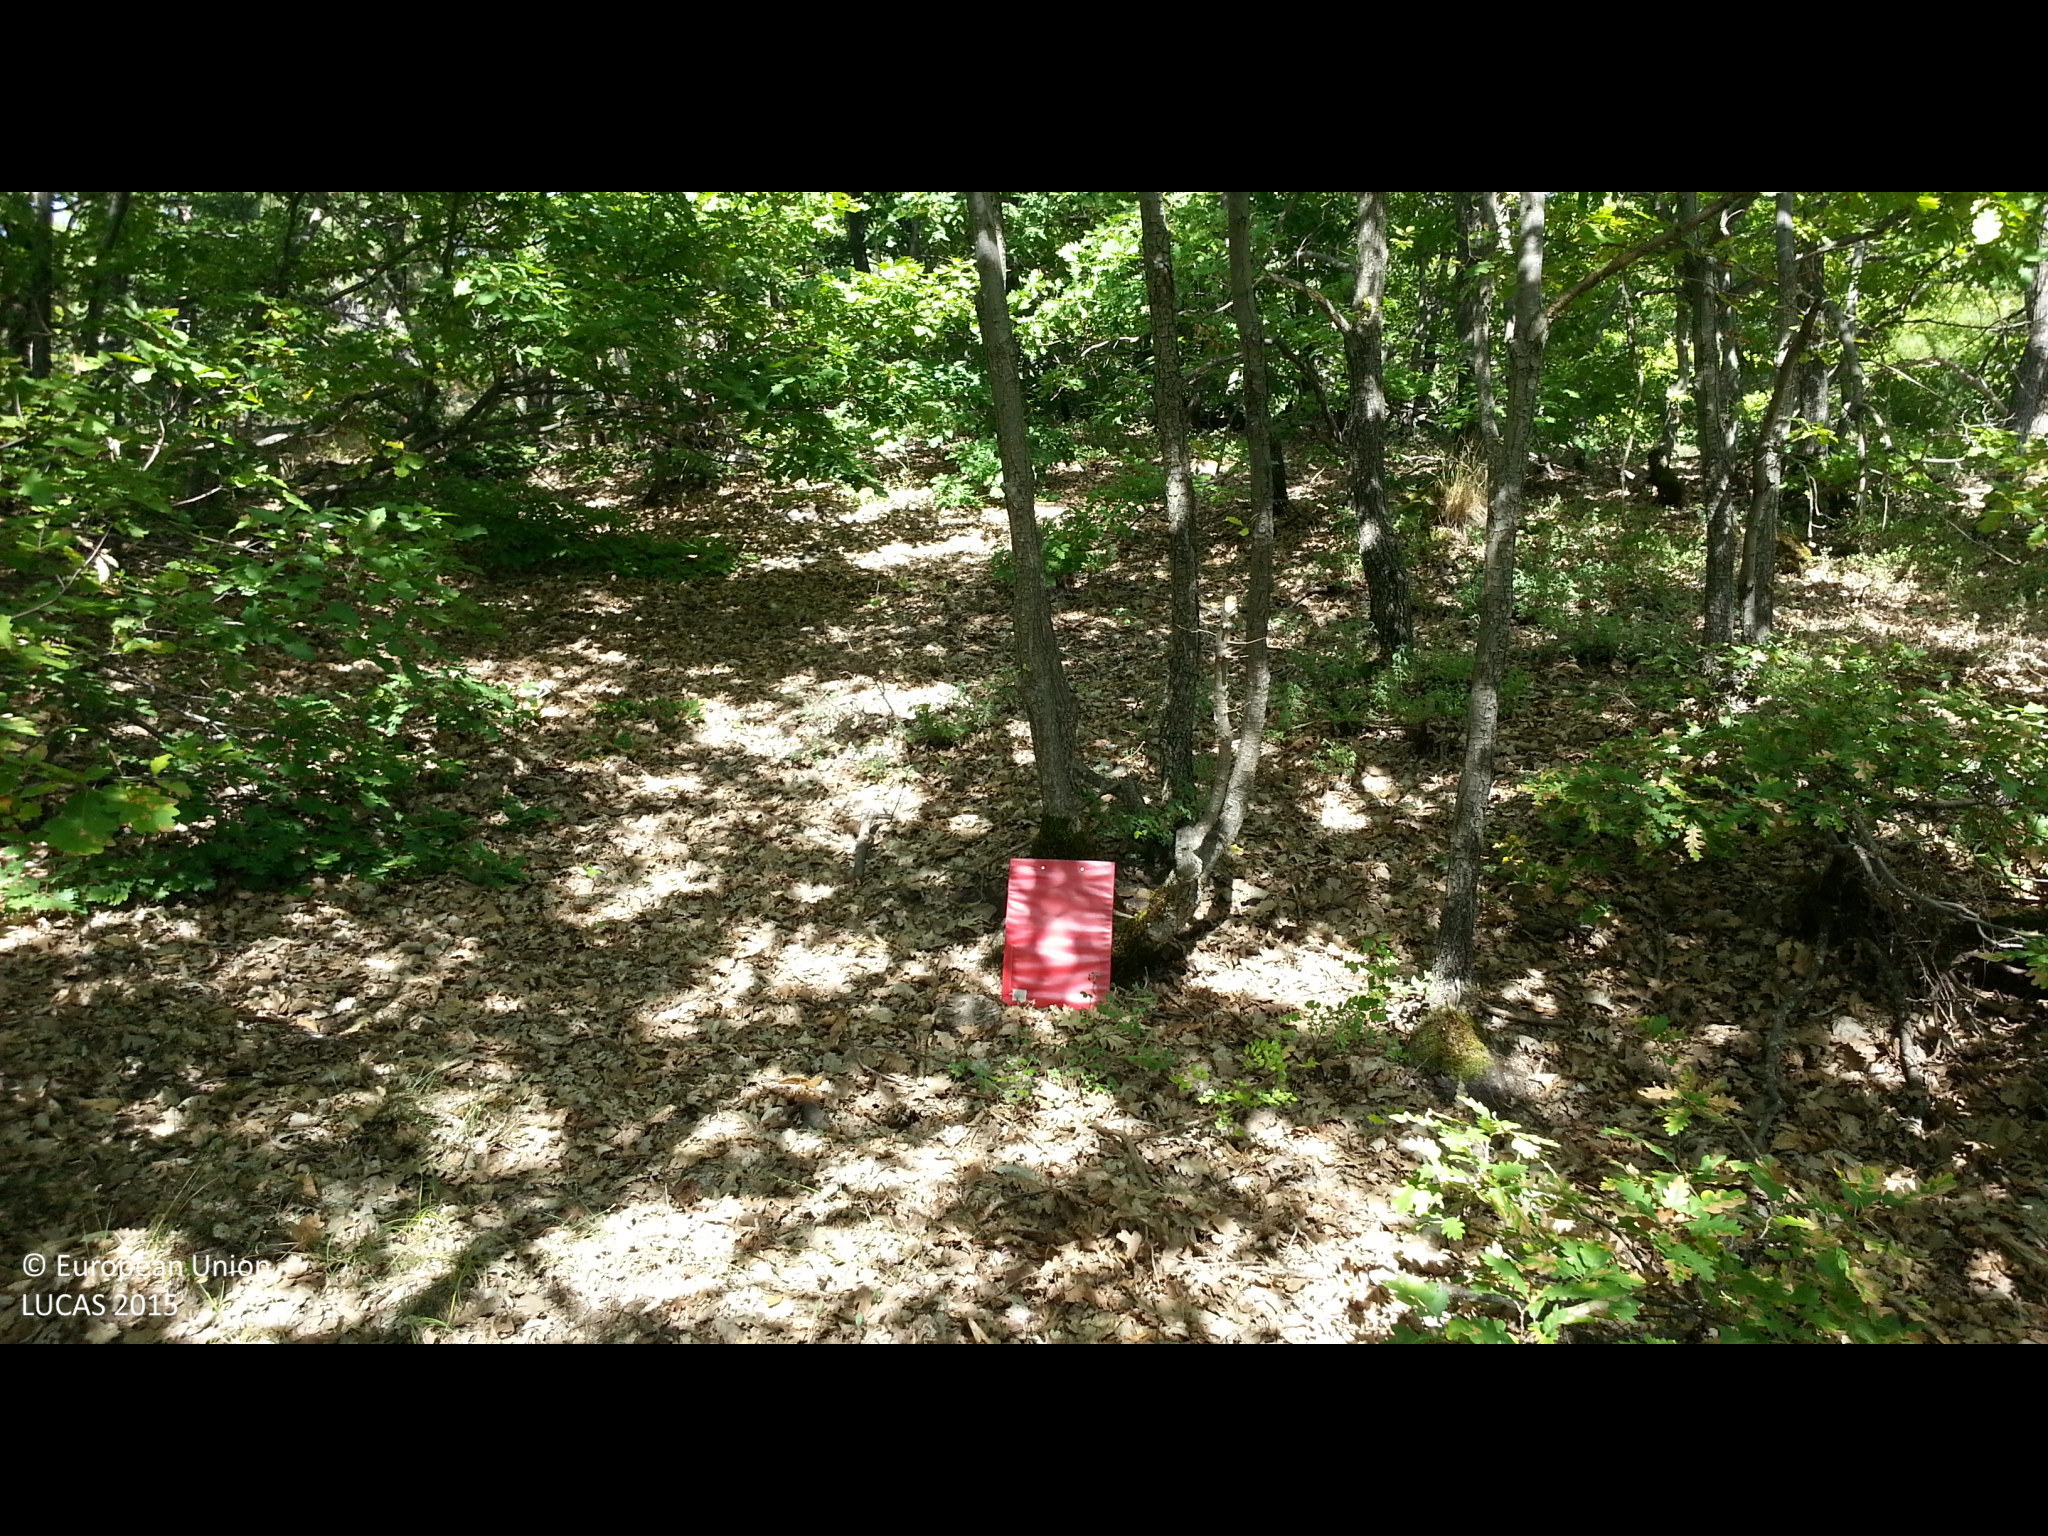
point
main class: Woodland
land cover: Broadleaved woodland
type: thermophilous deciduous forest
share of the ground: > 75 %
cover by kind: broadleaved forest trees 95 %, shrubs 5 %
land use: Forestry
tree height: > 5 m
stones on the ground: 10 - 25 %
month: September
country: BG
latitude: 42.0613
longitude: 22.7695
